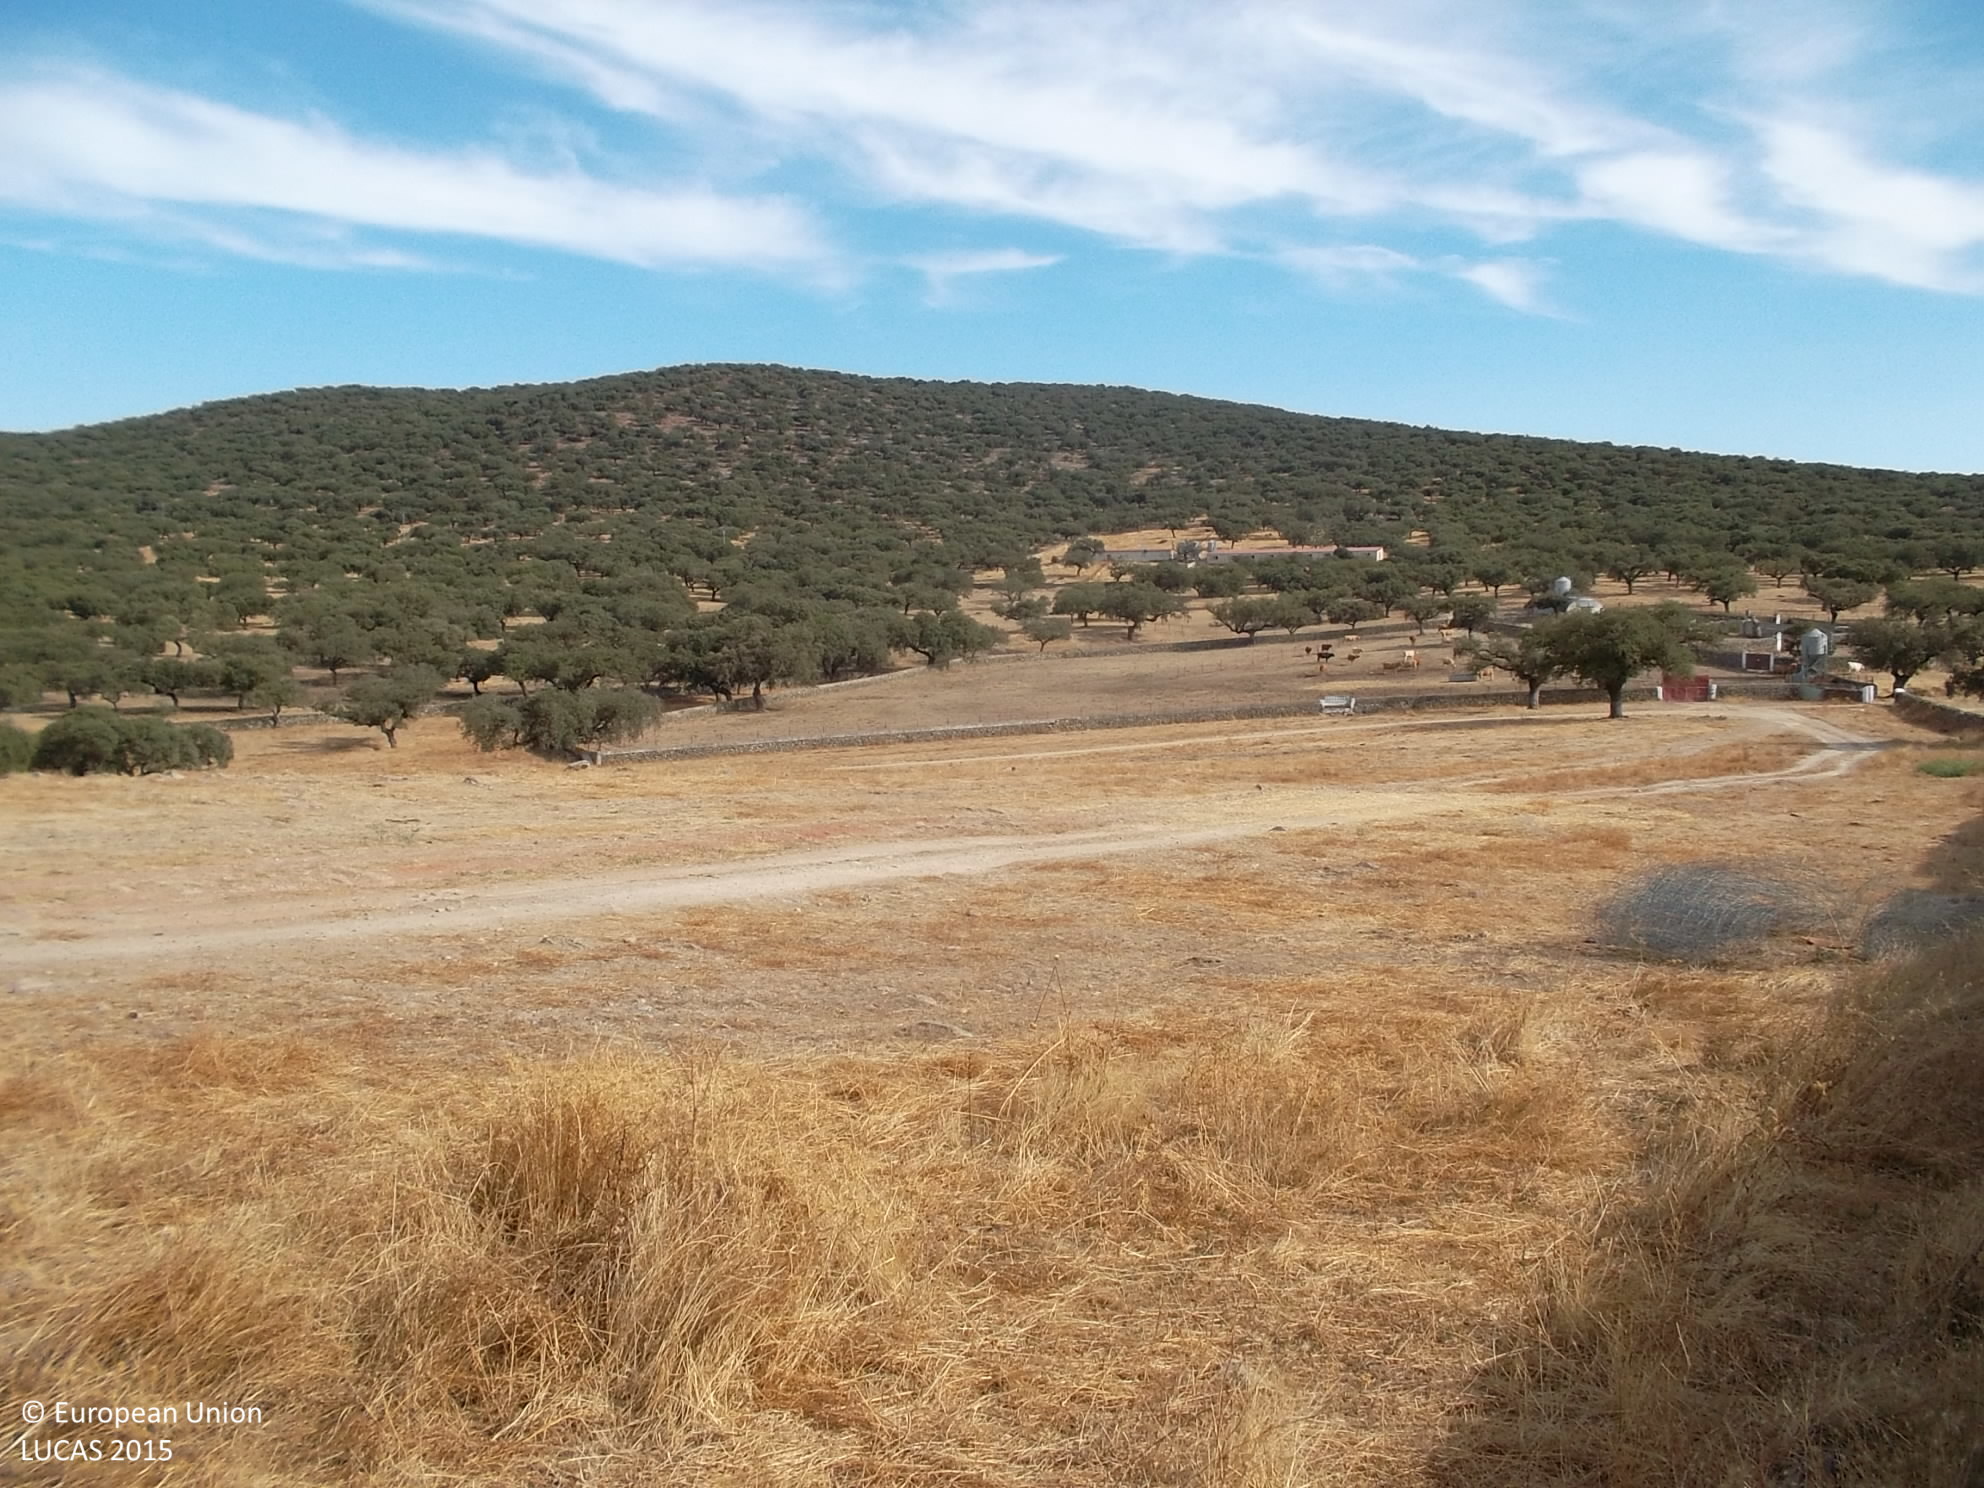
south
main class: Grassland
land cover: Grassland without tree/shrub cover
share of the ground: > 75 %
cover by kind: herbaceous plants 100 %
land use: Agriculture (excluding fallow land and kitchen gardens)
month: August
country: ES
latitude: 38.1444
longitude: -6.7916
